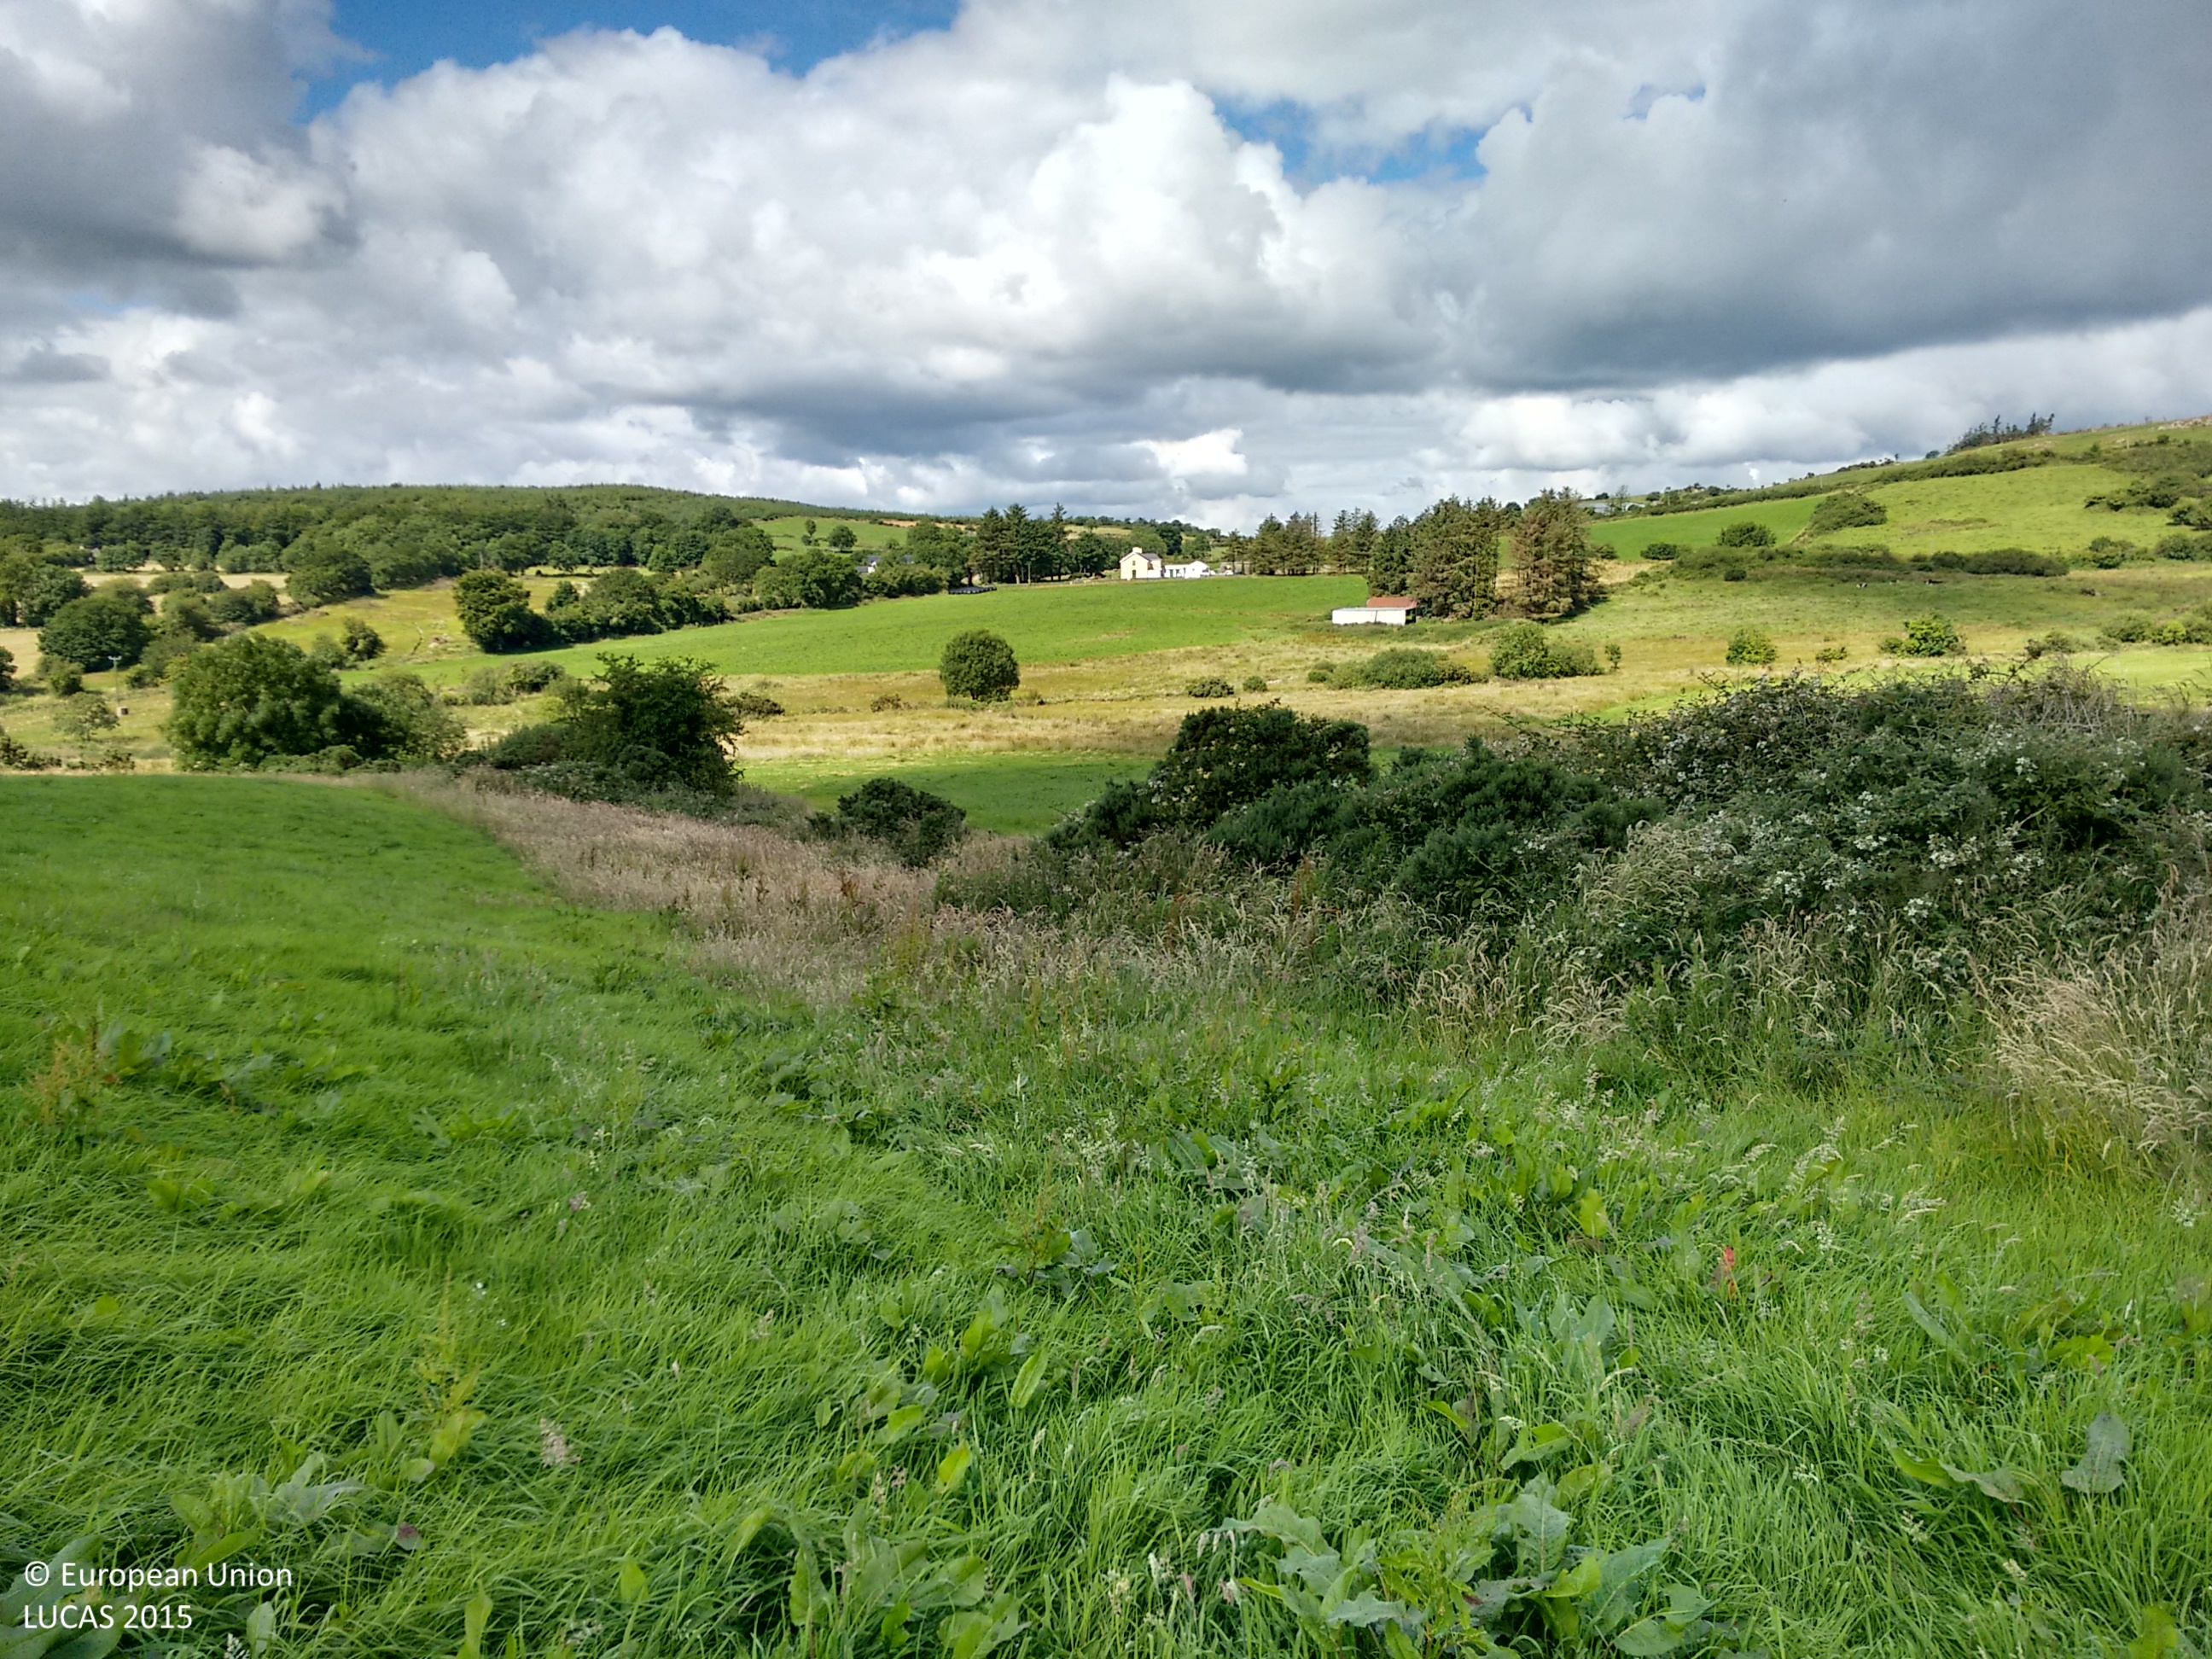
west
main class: Grassland
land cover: Grassland without tree/shrub cover
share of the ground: > 75 %
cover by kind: herbaceous plants 95 %, shrubs 5 %
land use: Agriculture (excluding fallow land and kitchen gardens)
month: July
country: IE
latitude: 52.8407
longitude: -8.4064
